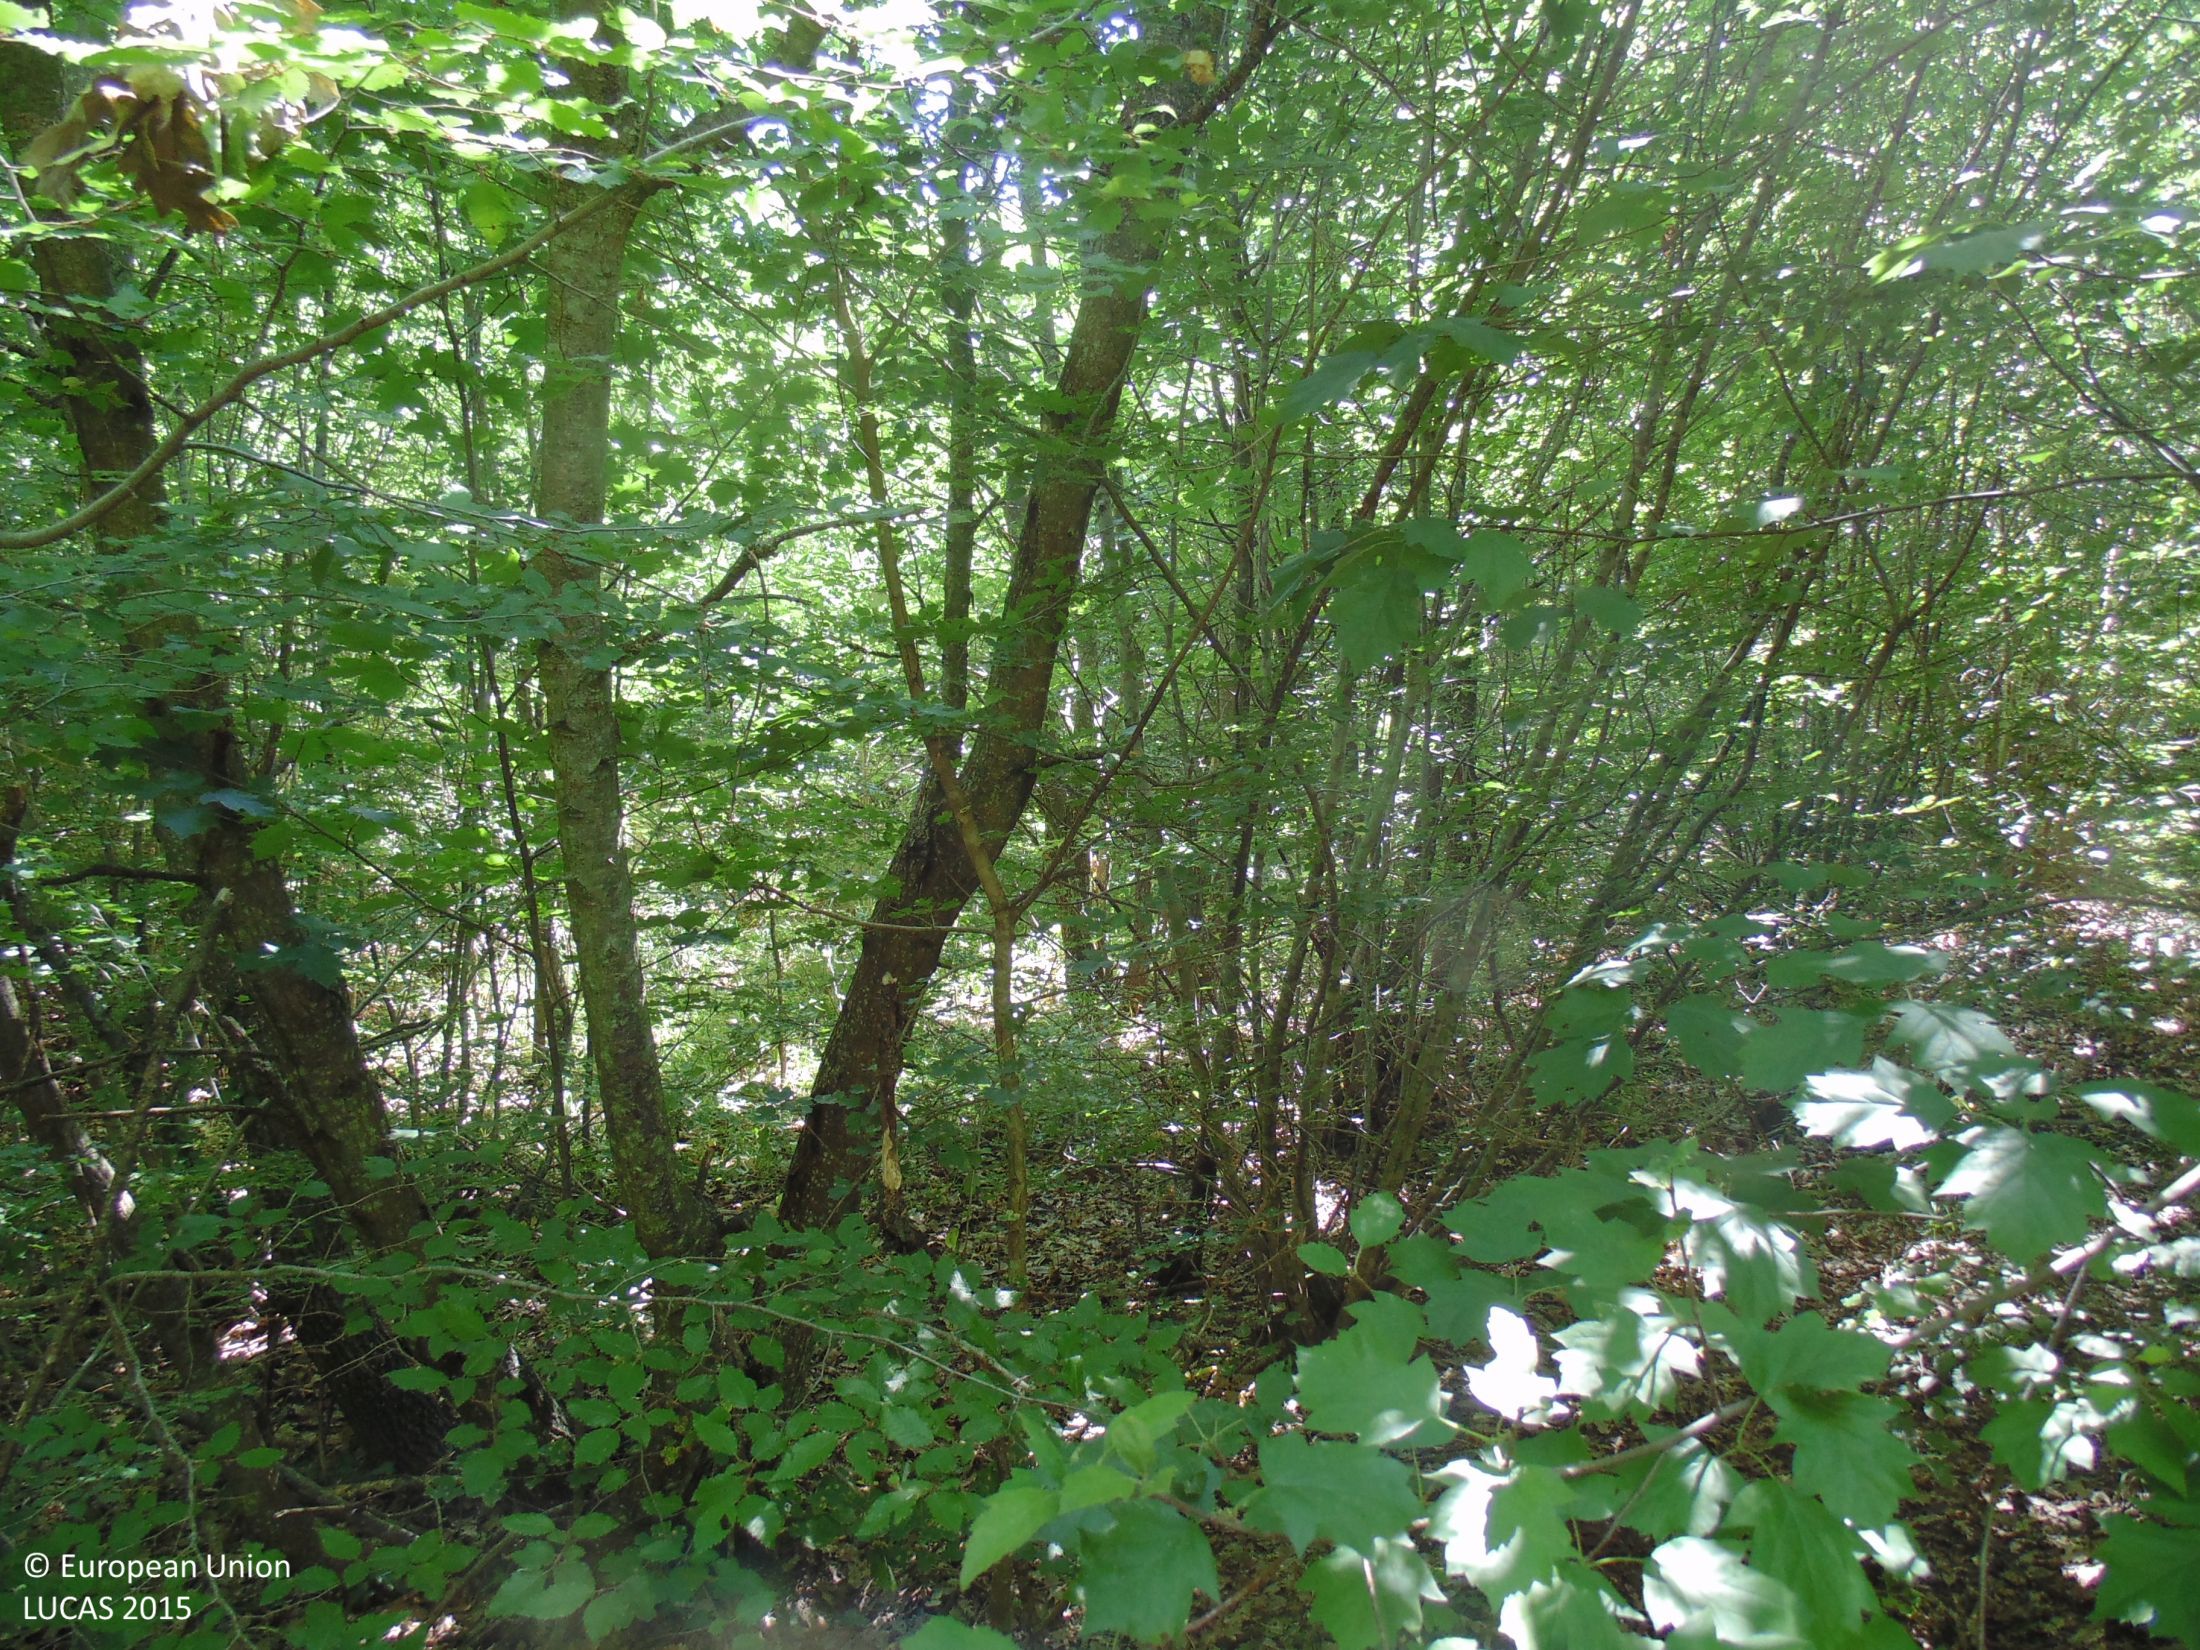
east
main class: Woodland
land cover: Broadleaved woodland
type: mesophytic deciduous forest
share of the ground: > 75 %
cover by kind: broadleaved forest trees 85 %, shrubs 10 %, unconsolidated bare surface 5 %
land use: Forestry
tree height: > 5 m
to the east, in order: Broadleaved woodland; Tracks; Broadleaved woodland; Tracks; Broadleaved woodland
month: July
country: BG
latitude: 43.3862
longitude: 27.9047
